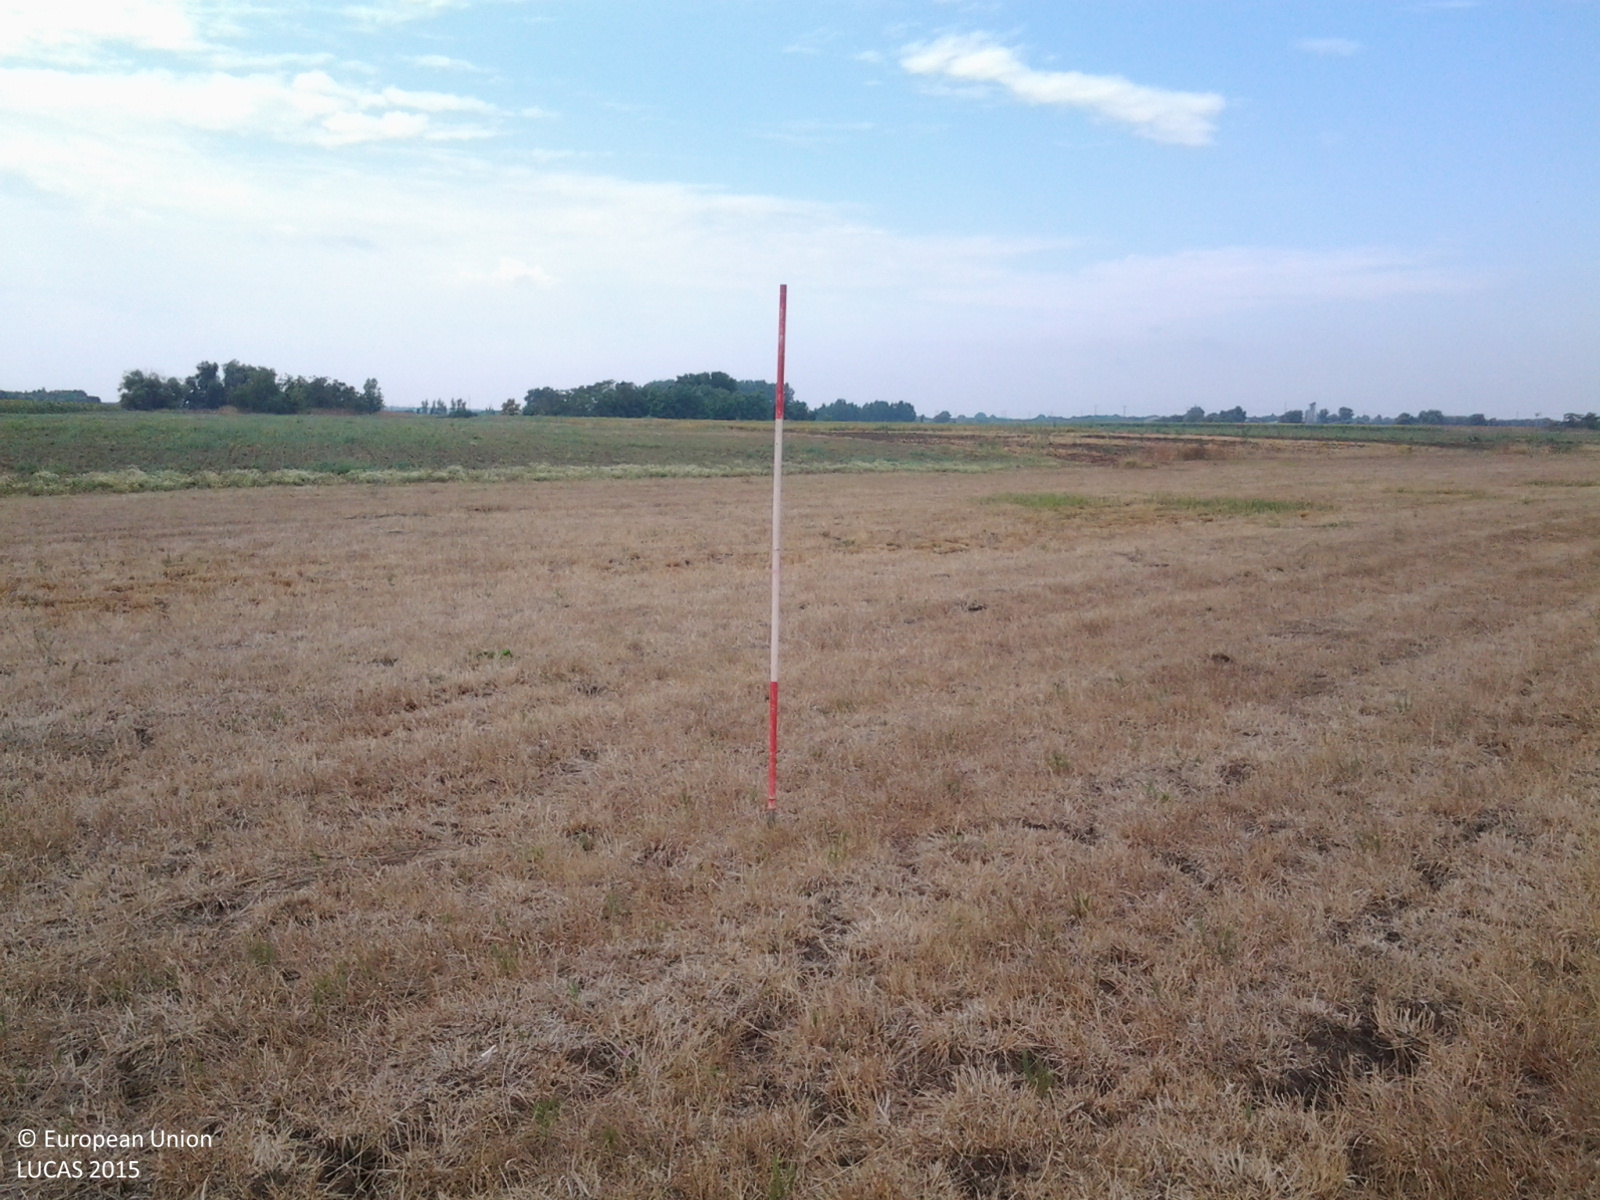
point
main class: Grassland
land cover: Grassland without tree/shrub cover
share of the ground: > 75 %
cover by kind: herbaceous plants 100 %
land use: Agriculture (excluding fallow land and kitchen gardens)
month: August
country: HU
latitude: 47.0322
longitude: 21.2090
